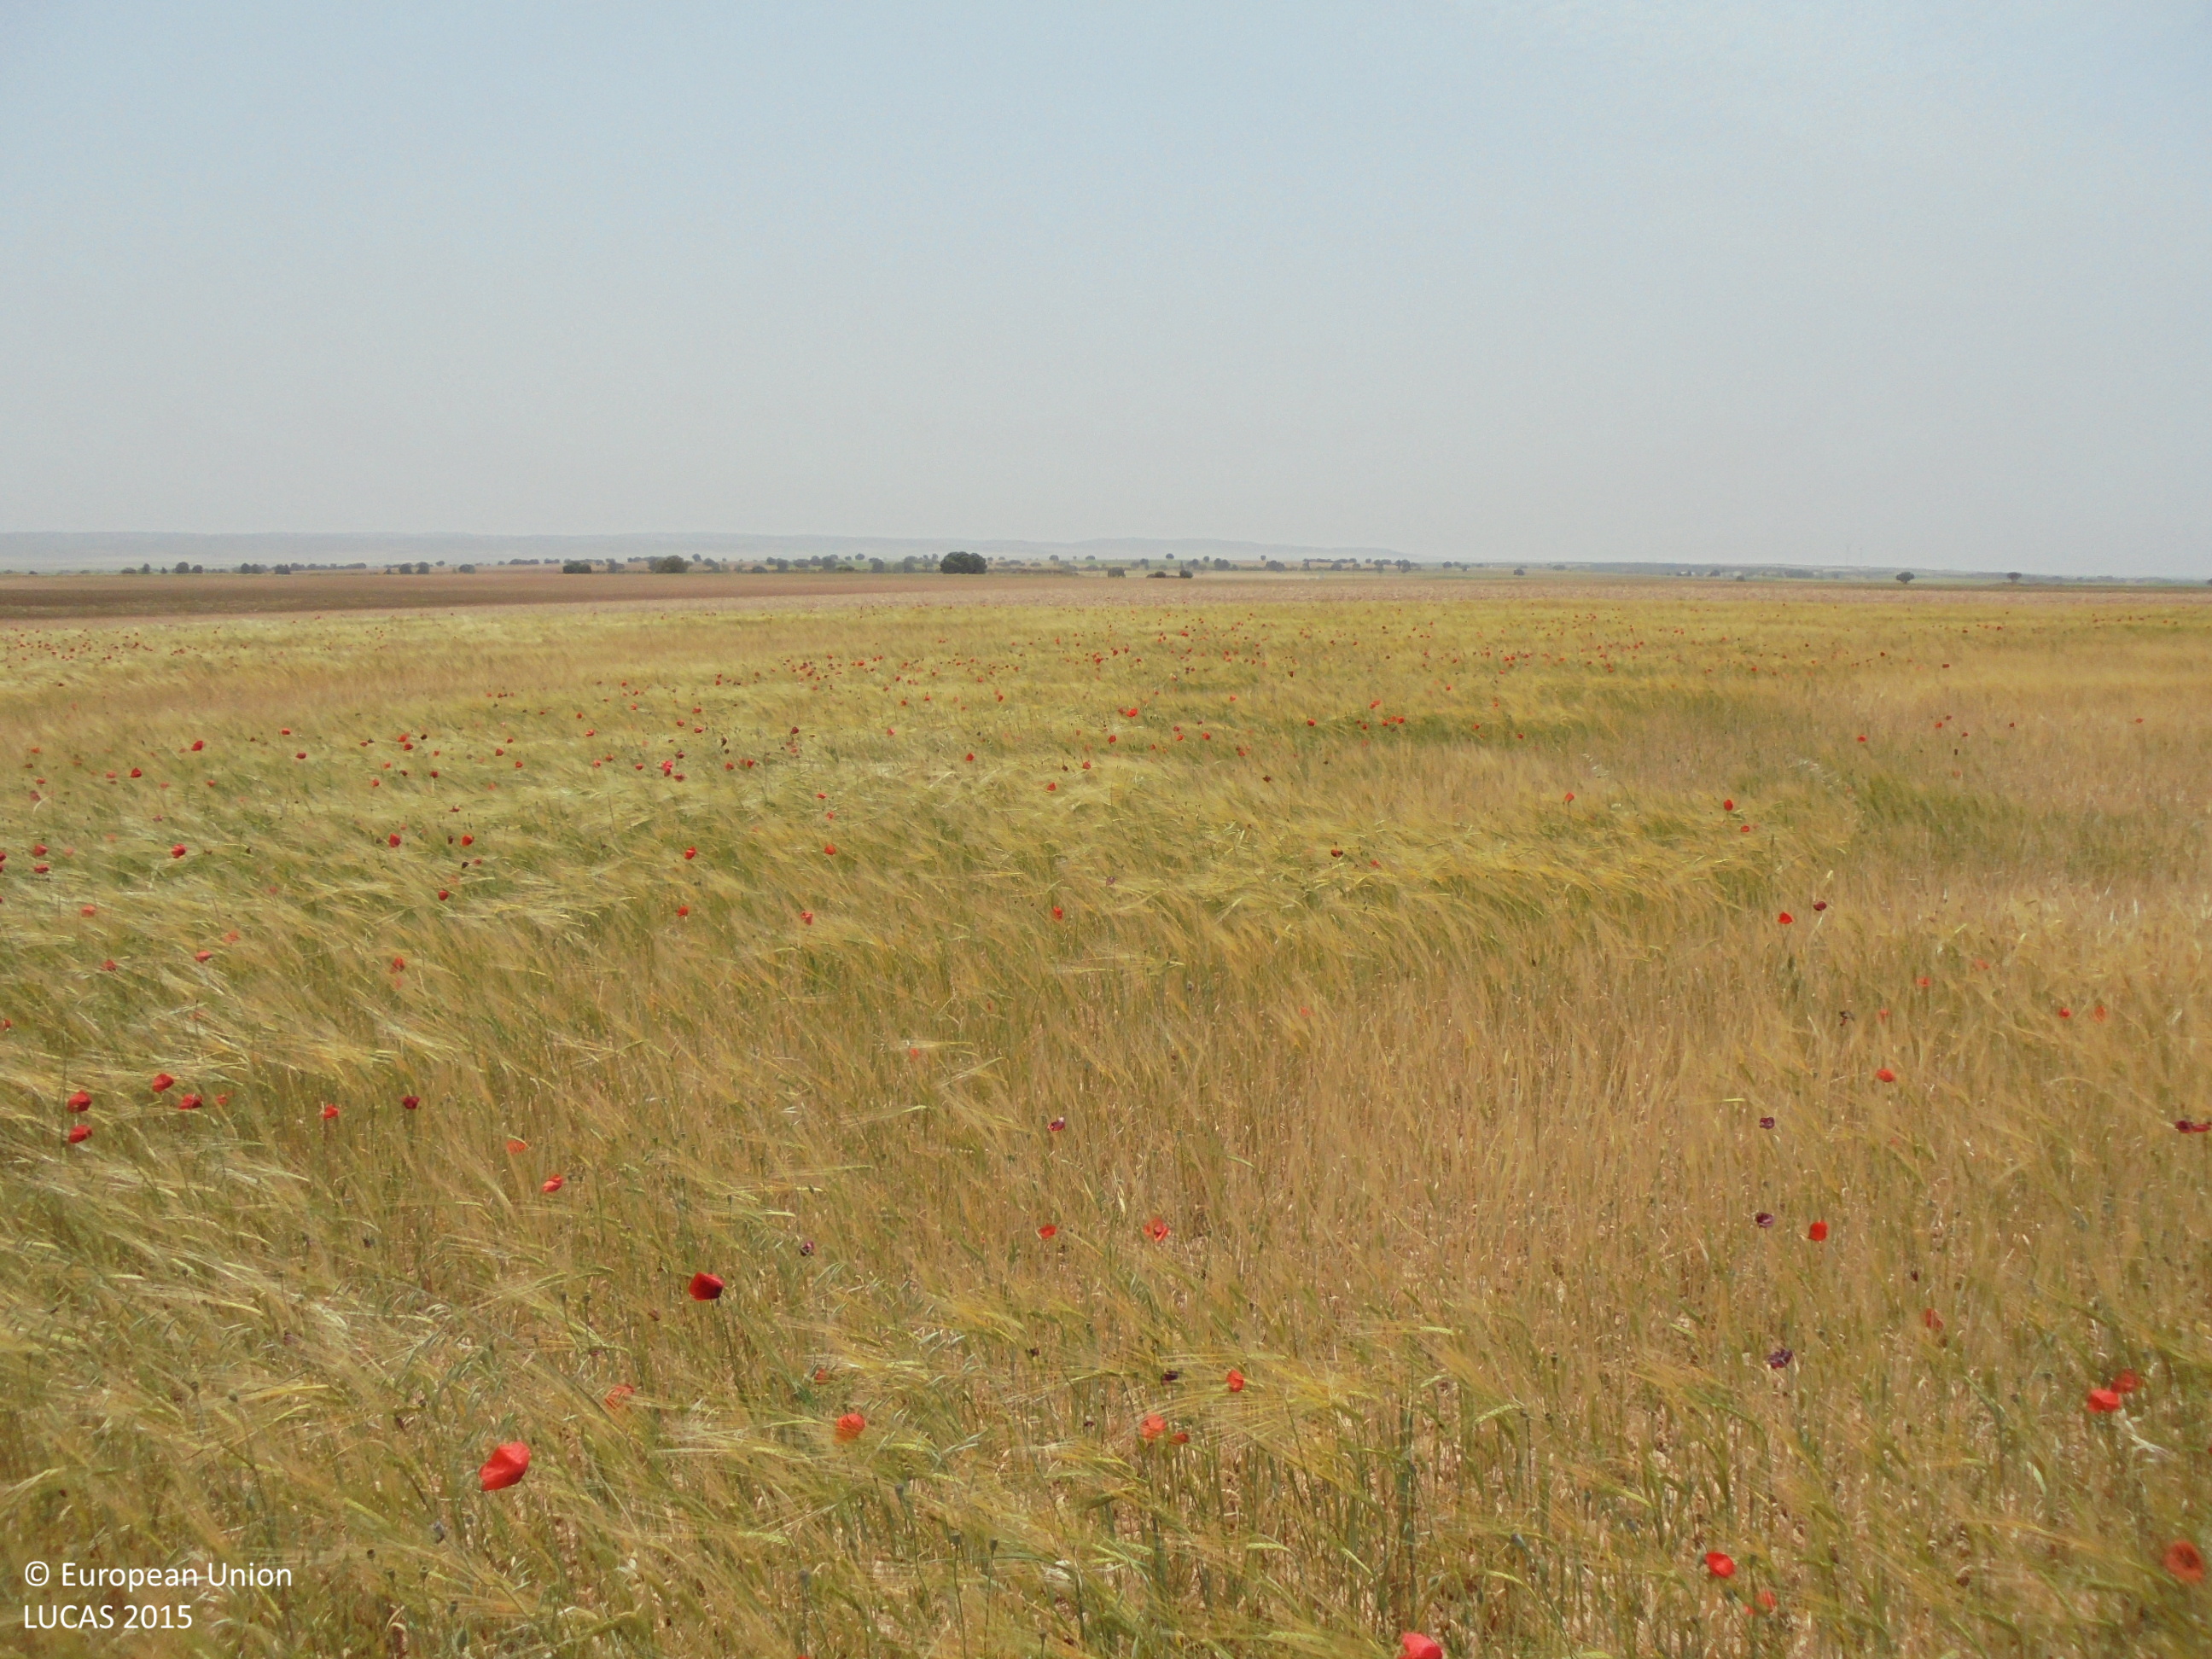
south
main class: Cropland
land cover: Barley
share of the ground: 50 - 75 %
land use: Agriculture (excluding fallow land and kitchen gardens)
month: May
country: ES
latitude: 39.1061
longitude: -1.7151
